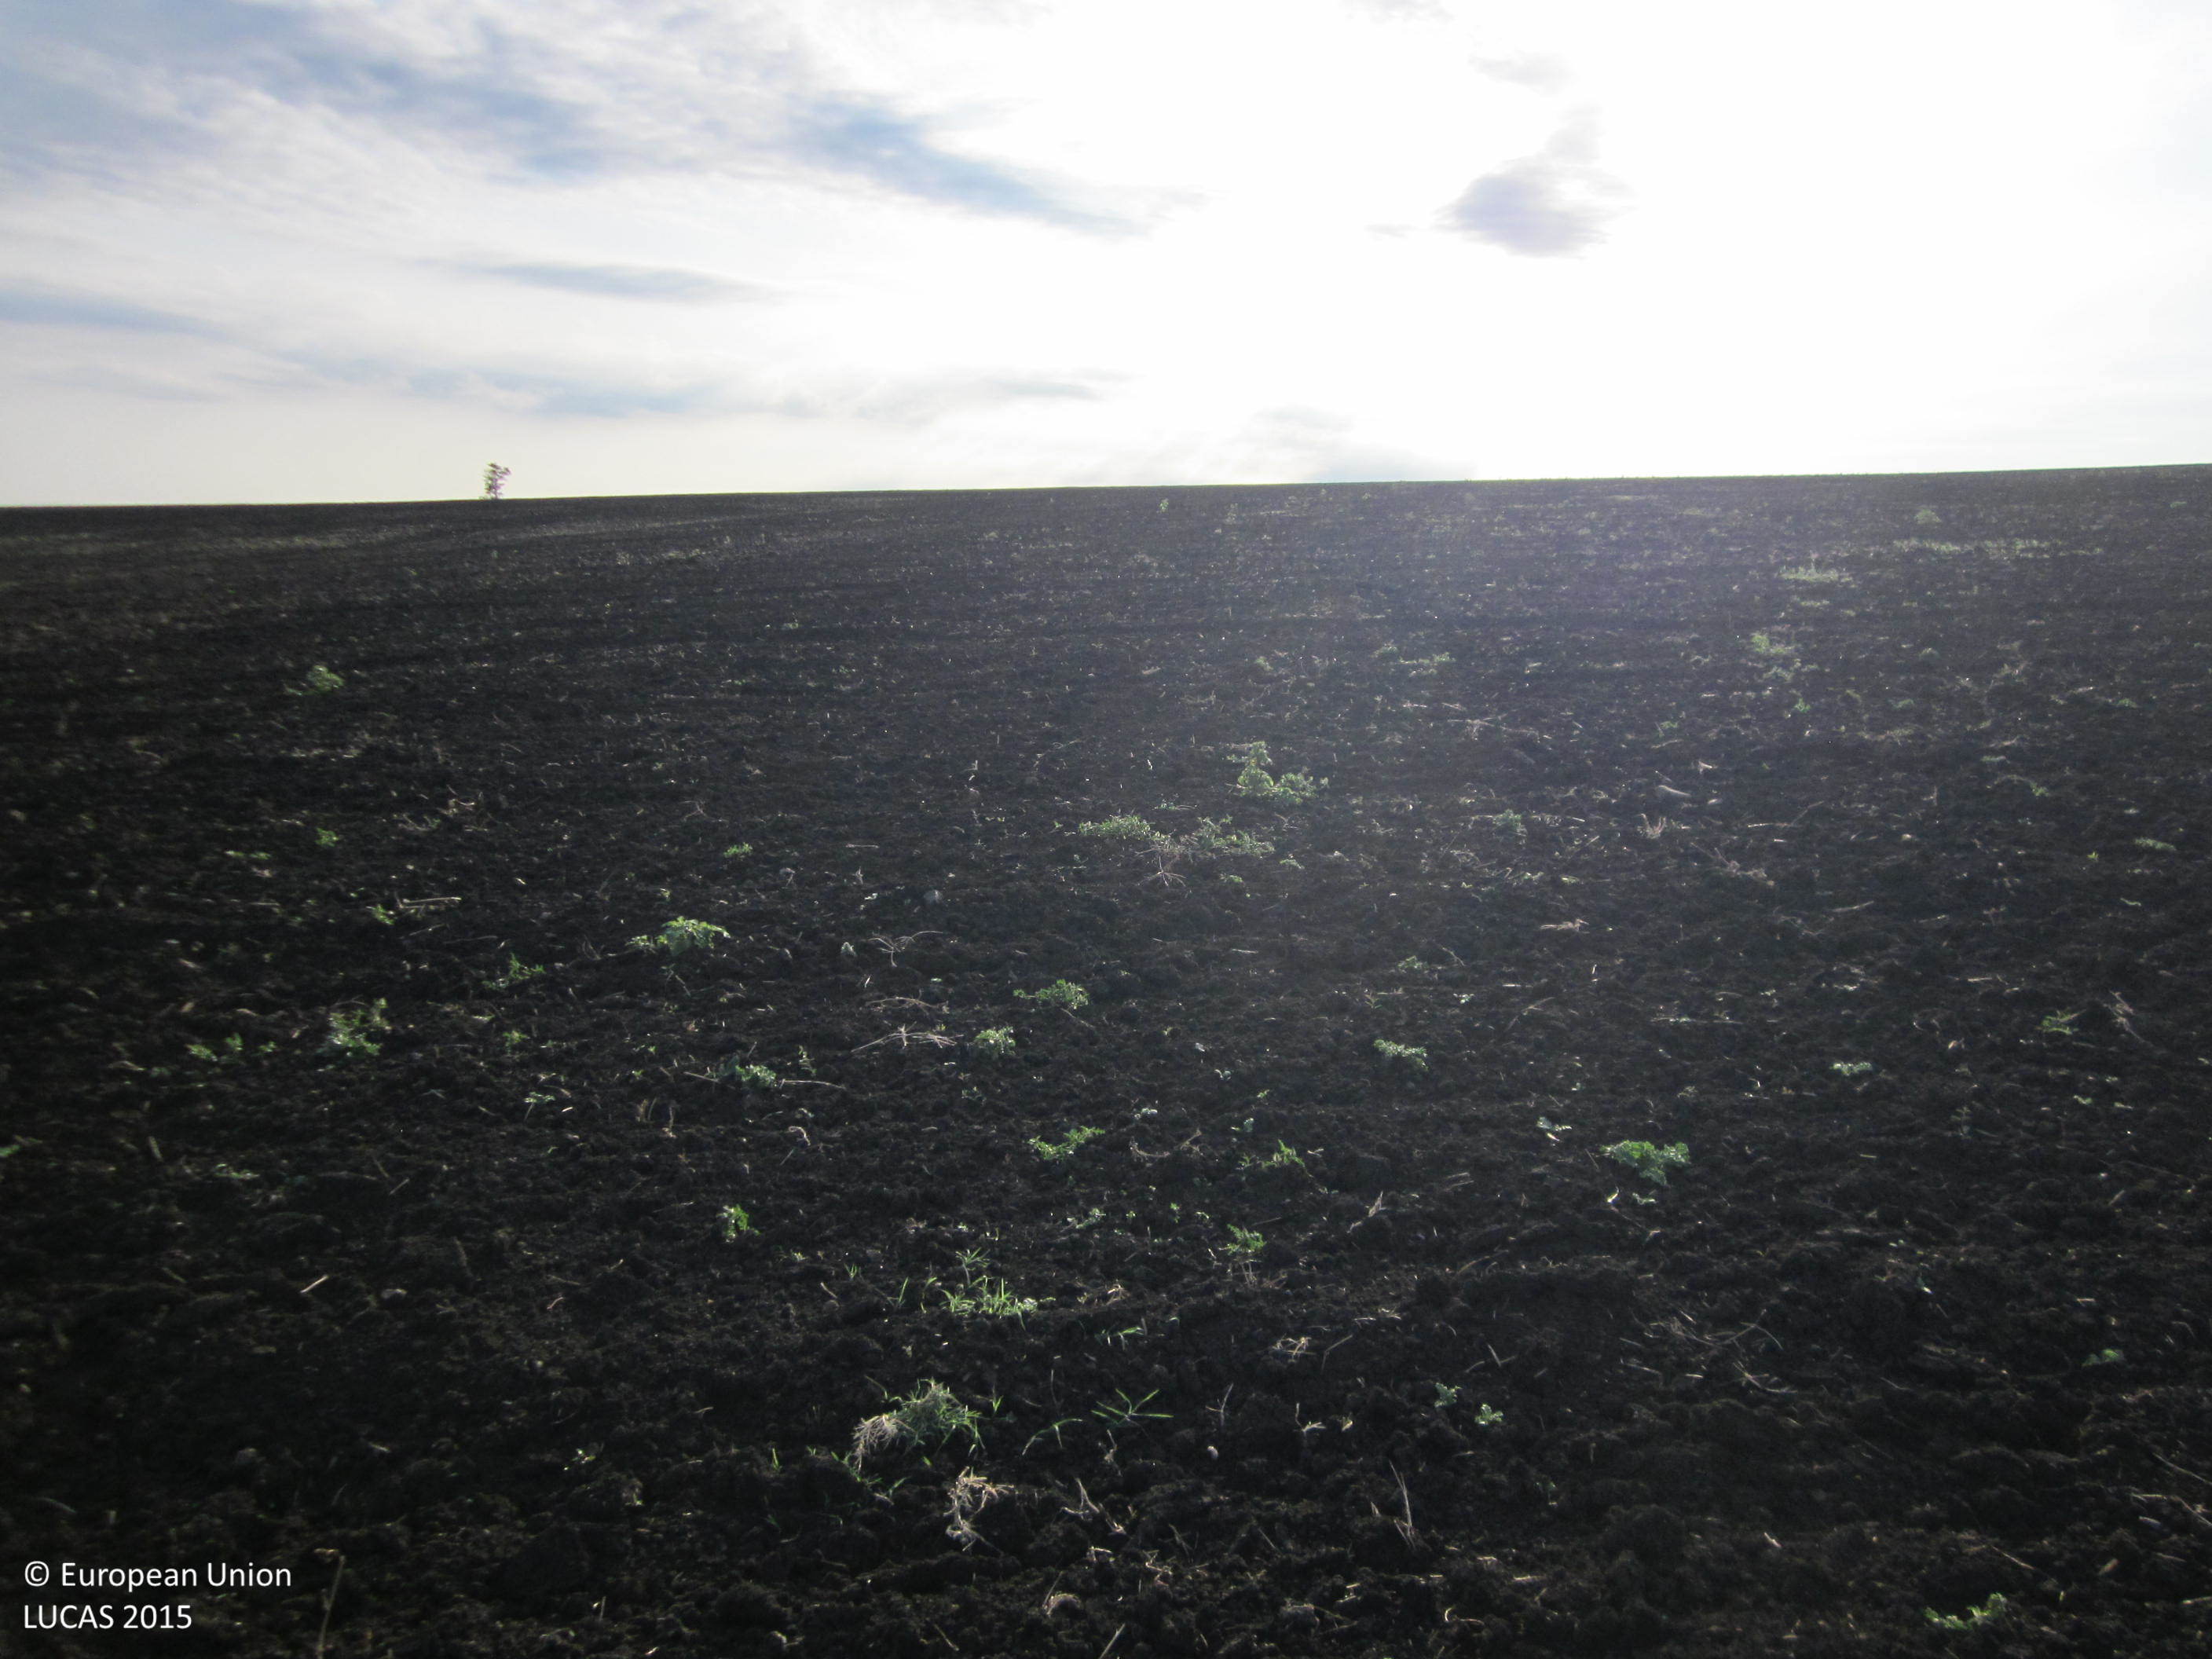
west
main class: Cropland
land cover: Sunflower
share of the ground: < 10 %
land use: Agriculture (excluding fallow land and kitchen gardens)
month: September
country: BG
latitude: 42.6207
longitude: 27.1171
